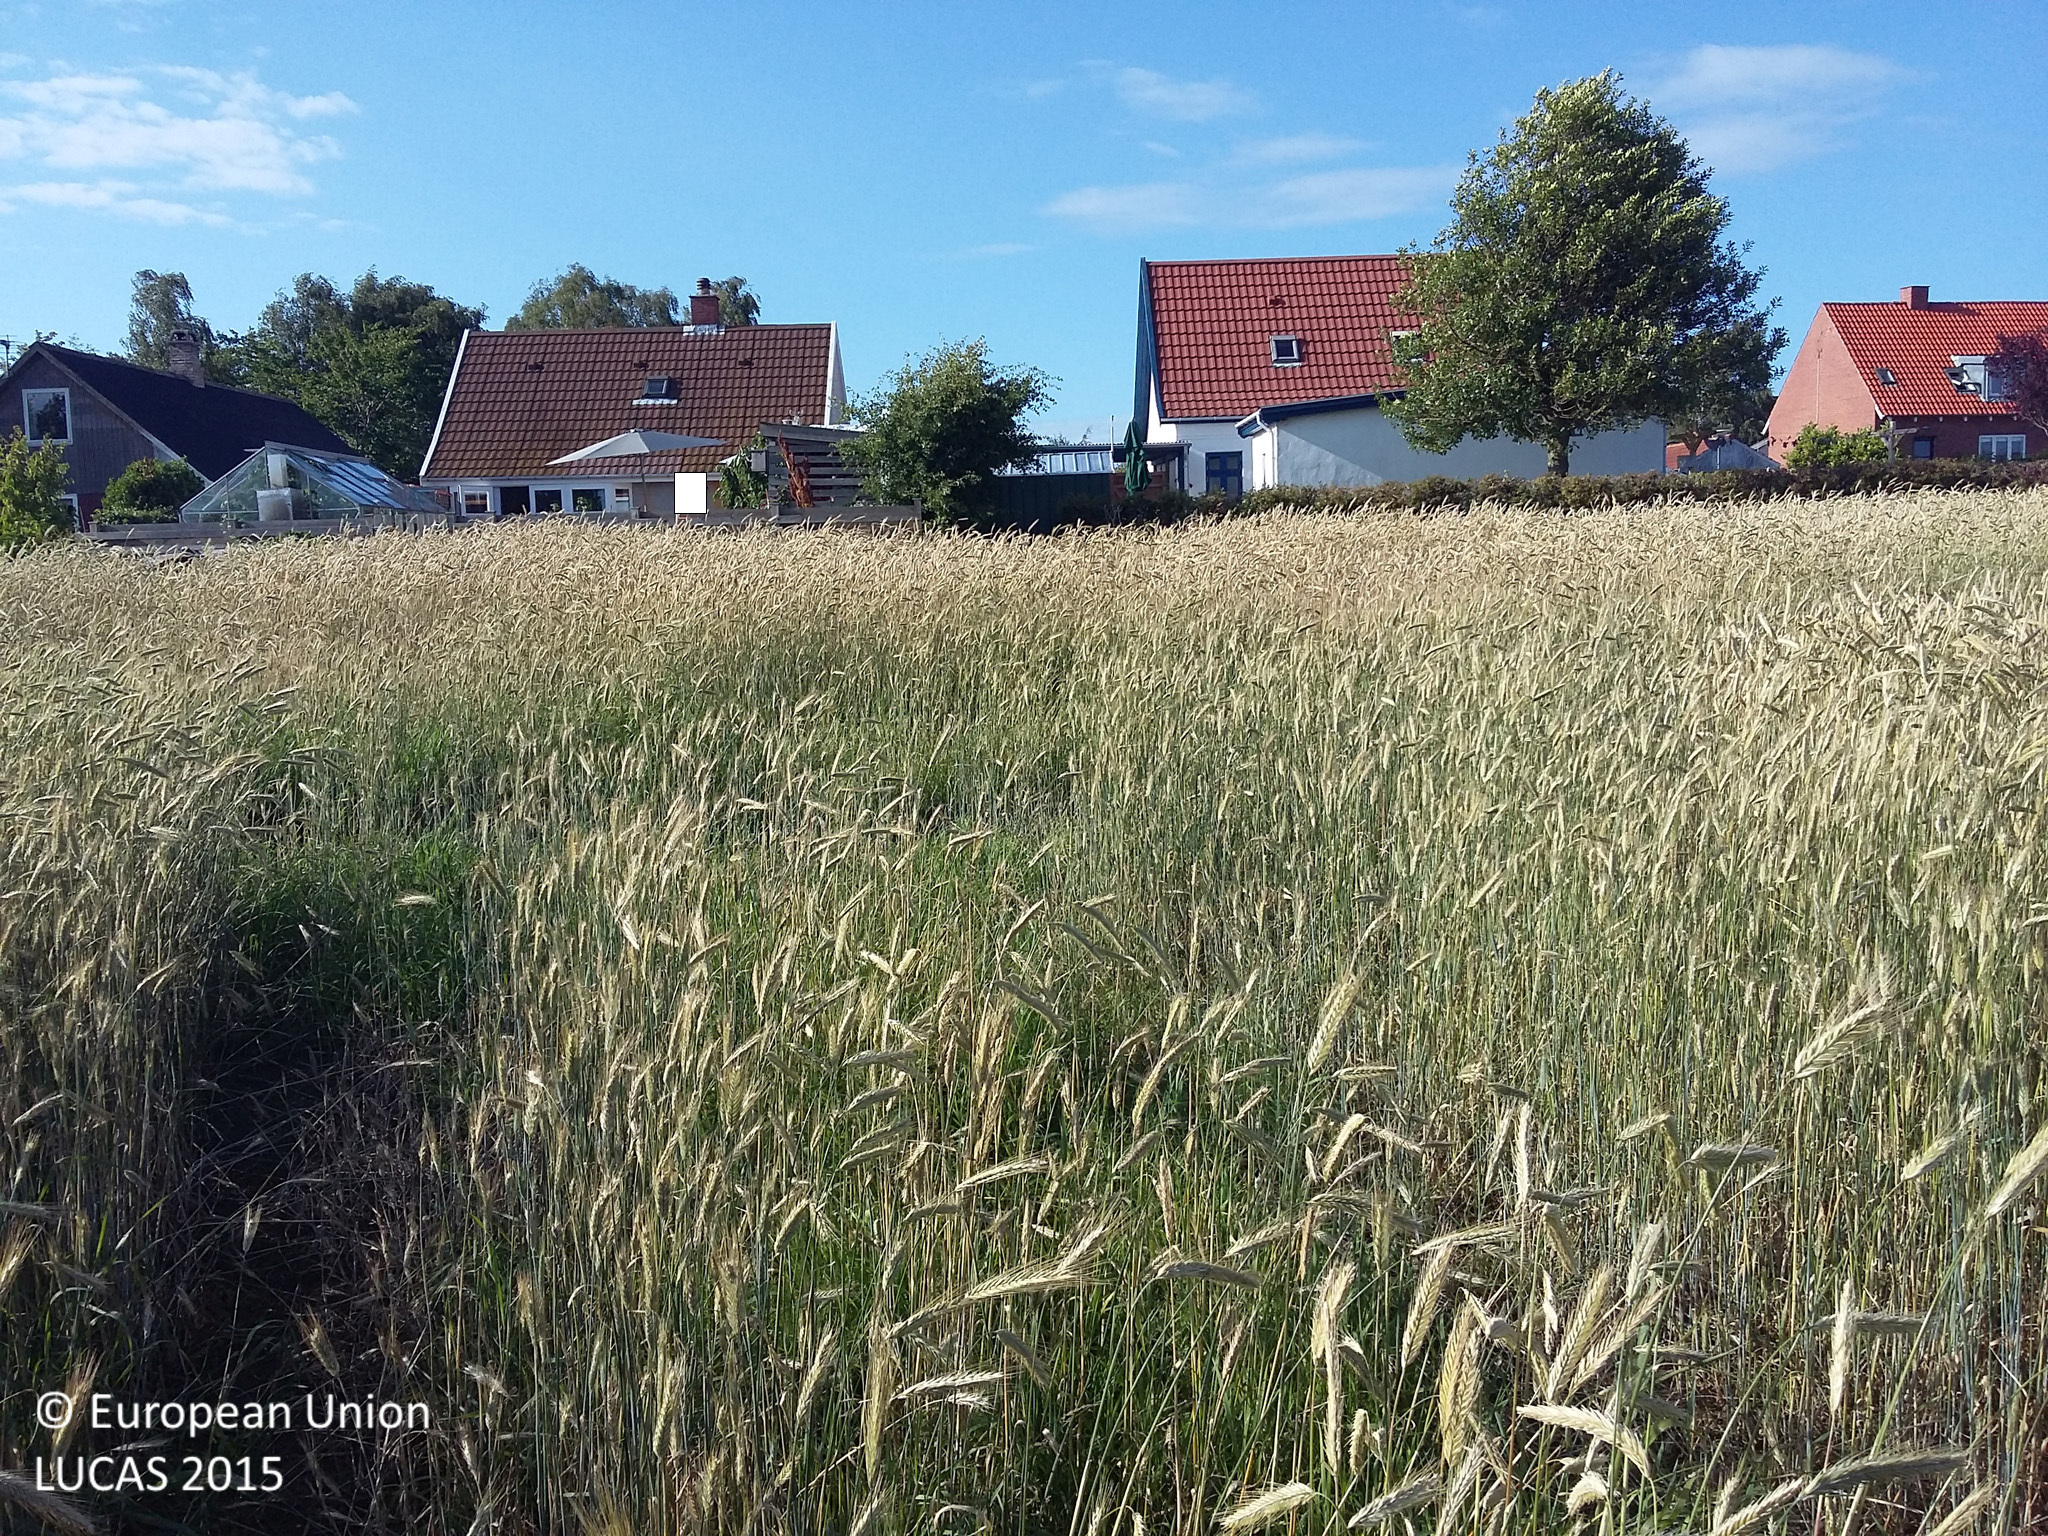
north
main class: Cropland
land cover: Rye
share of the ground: > 75 %
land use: Agriculture (excluding fallow land and kitchen gardens)
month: July
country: DK
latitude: 55.9251
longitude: 11.6787
